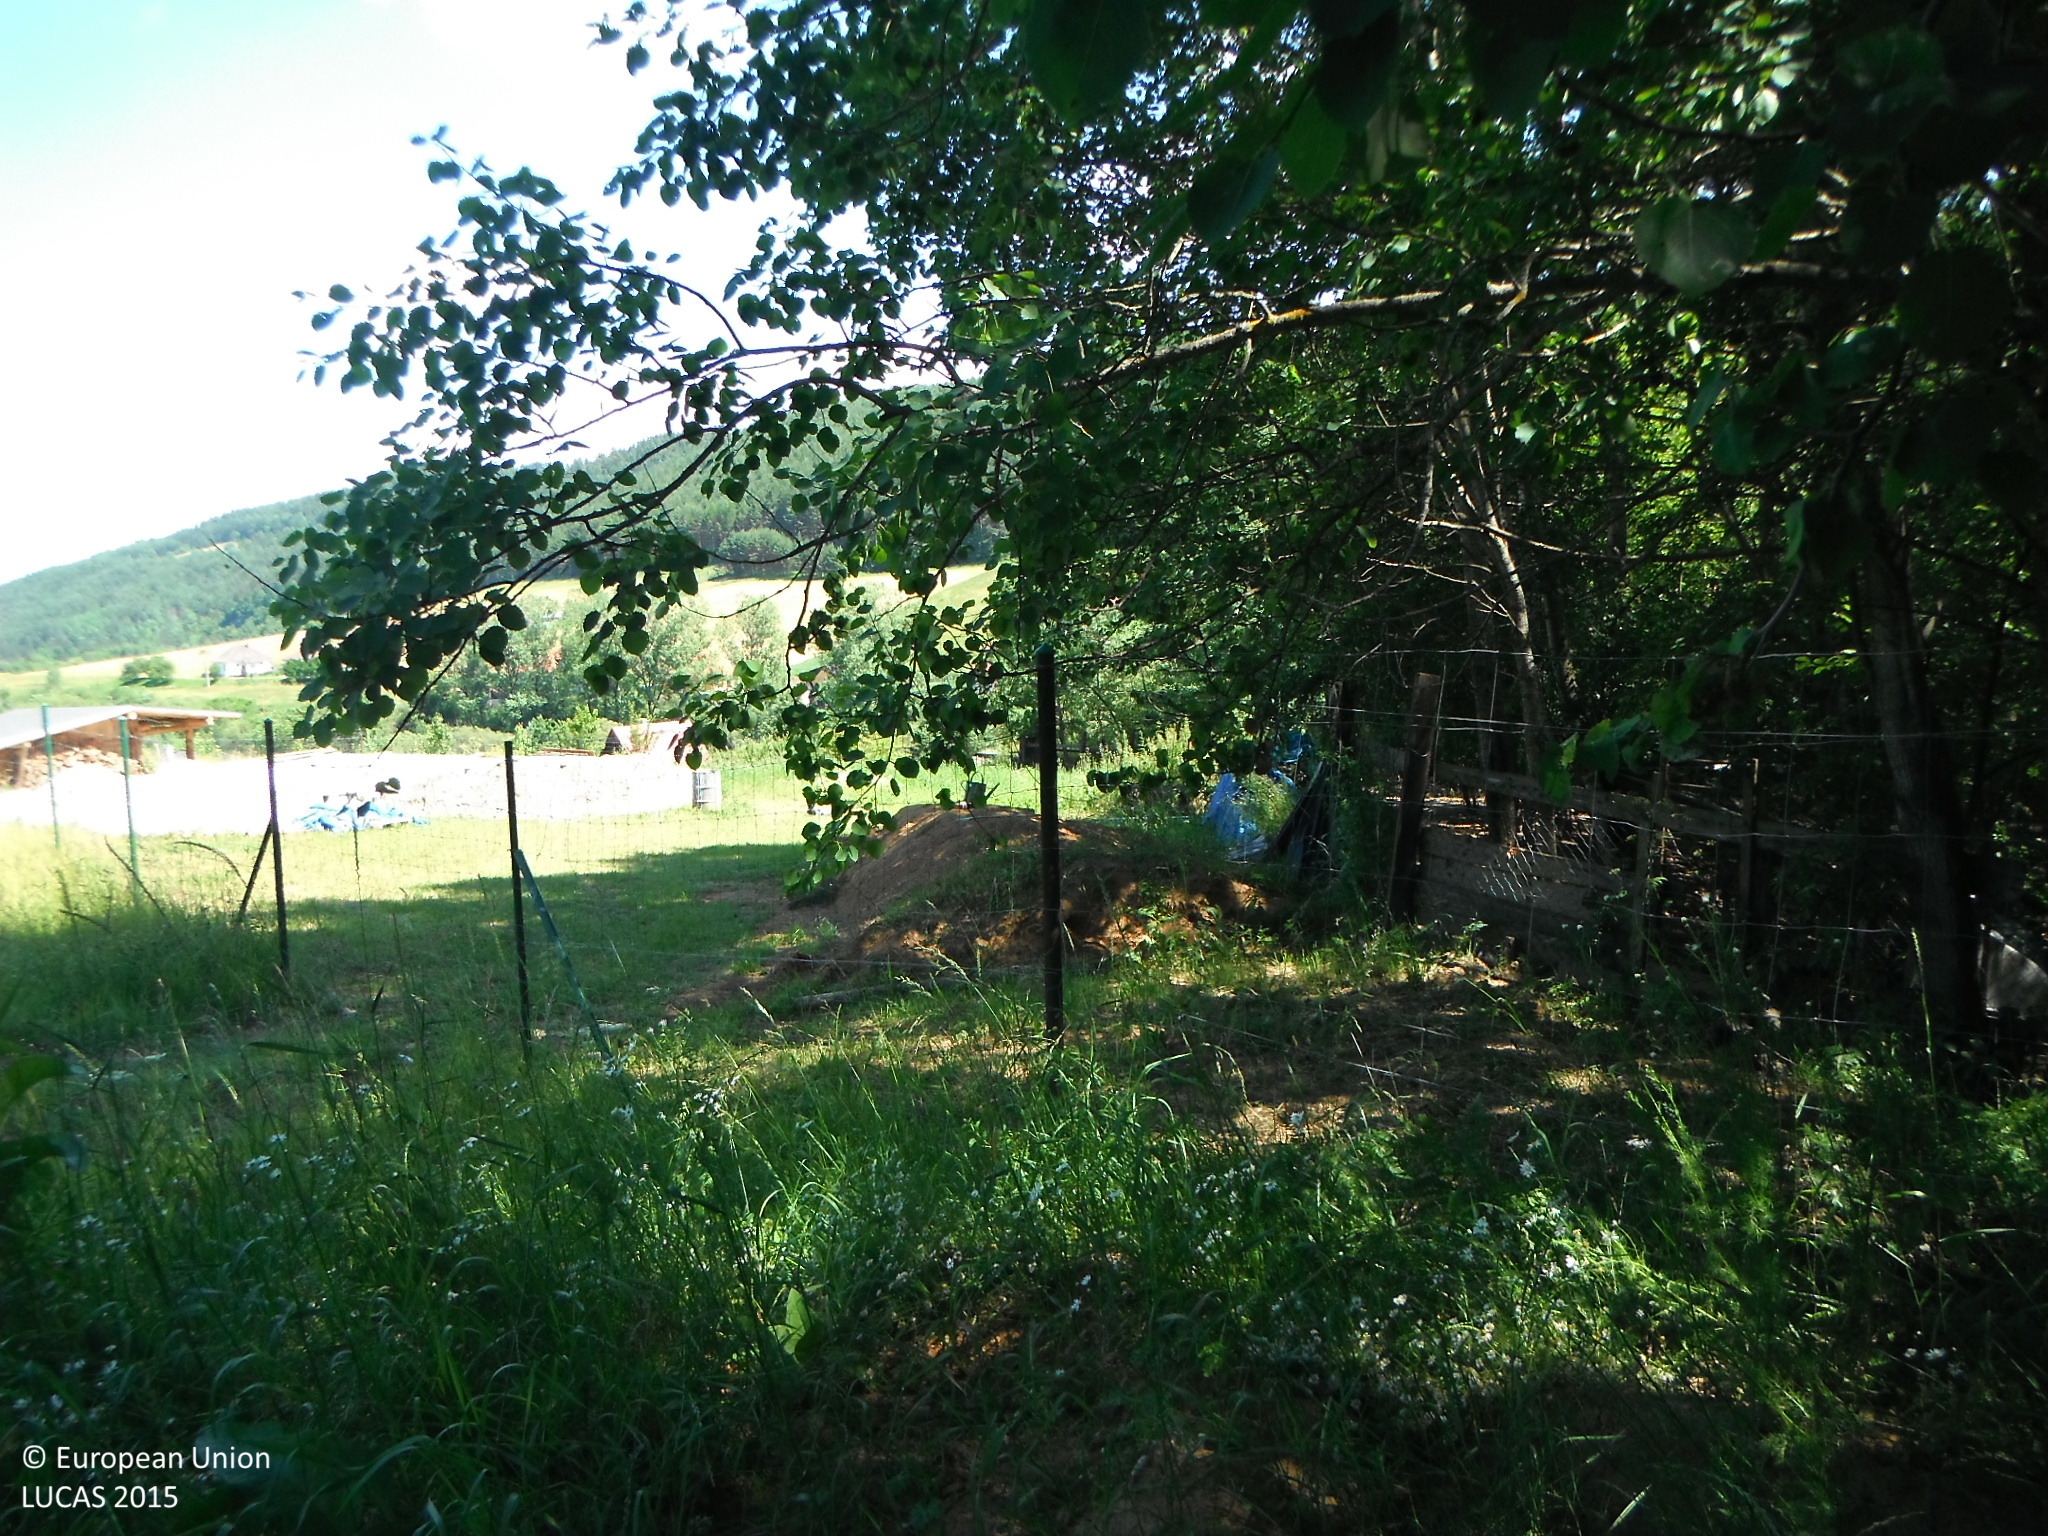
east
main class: Woodland
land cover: Broadleaved woodland
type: mesophytic deciduous forest
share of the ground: 50 - 75 %
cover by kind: broadleaved forest trees 60 %, herbaceous plants 40 %
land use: Forestry
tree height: > 5 m
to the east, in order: Broadleaved woodland; Fences; Grassland without tree/shrub cover; Artificial constructions in urban areas; Grassland without tree/shrub cover; Artificial constructions in urban areas; Grassland without tree/shrub cover; Artificial constructions in urban areas
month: July
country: SK
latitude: 48.9201
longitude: 20.6688
